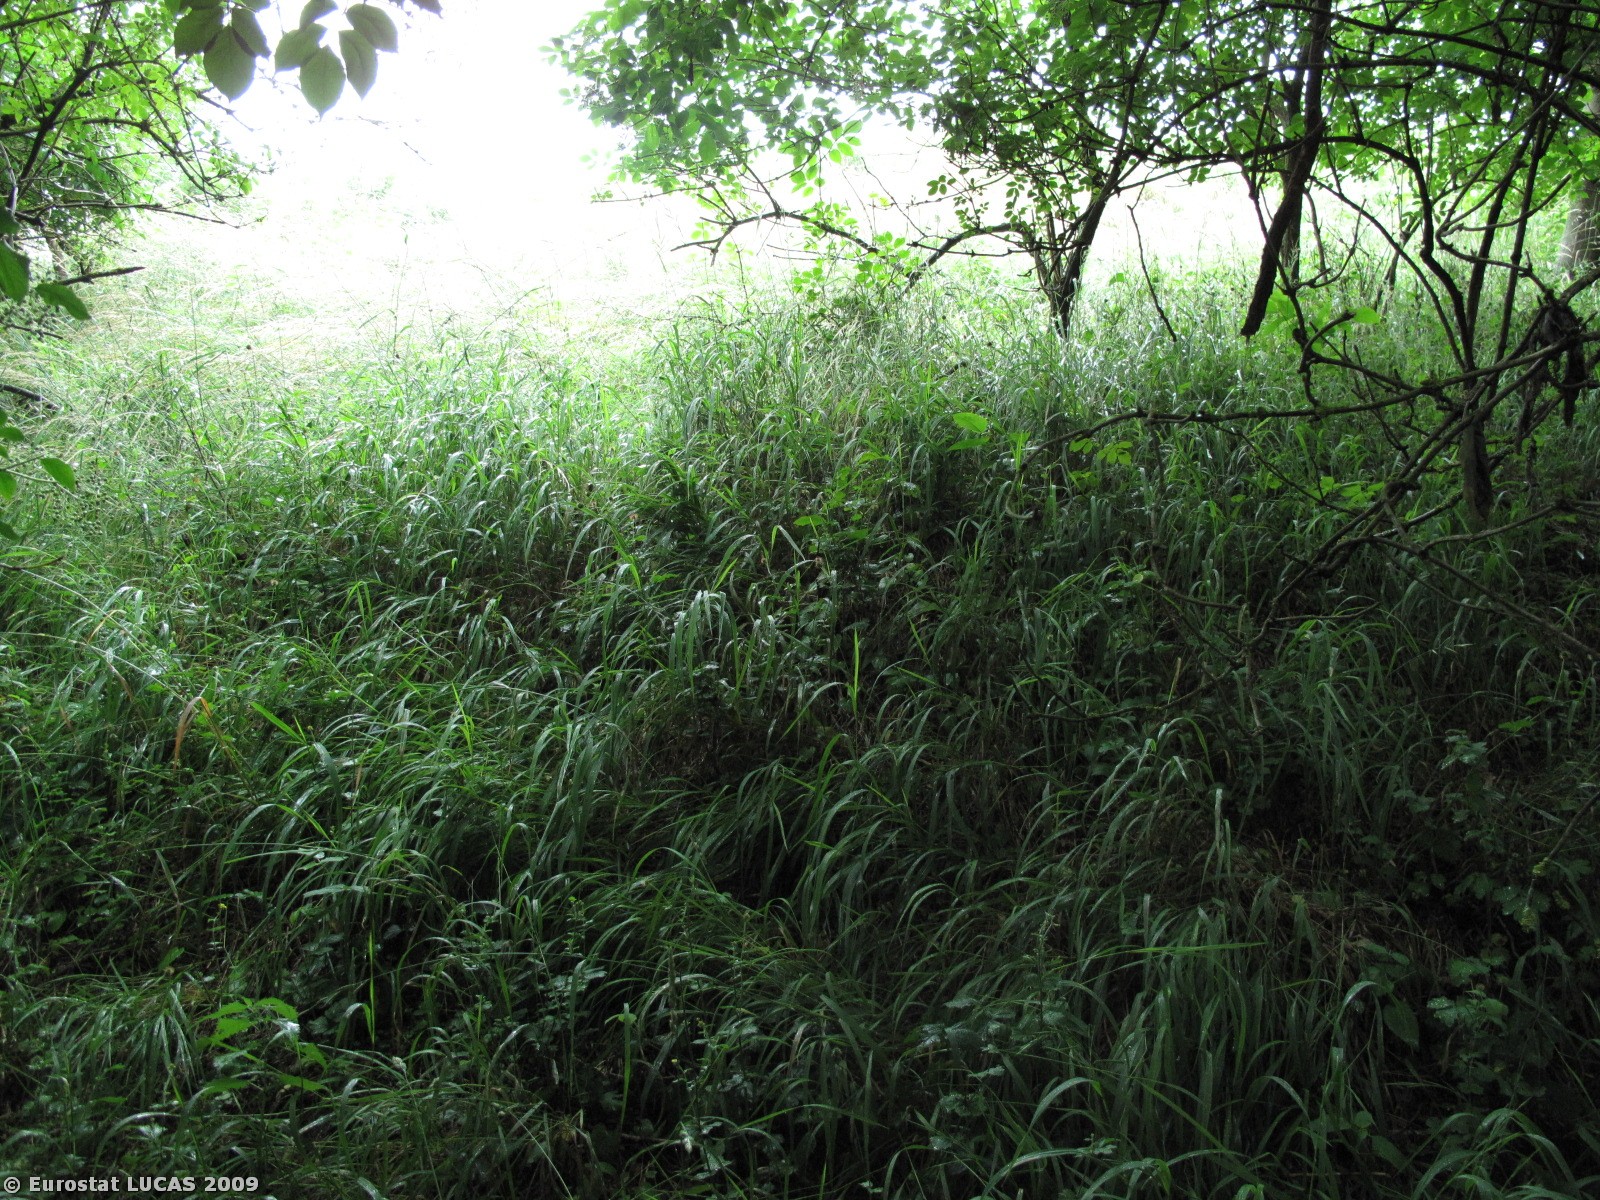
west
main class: Woodland
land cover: Broadleaved woodland
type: mesophytic deciduous forest
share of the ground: > 75 %
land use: Unused
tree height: > 5 m
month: June
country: AT
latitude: 48.2659
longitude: 15.8637
